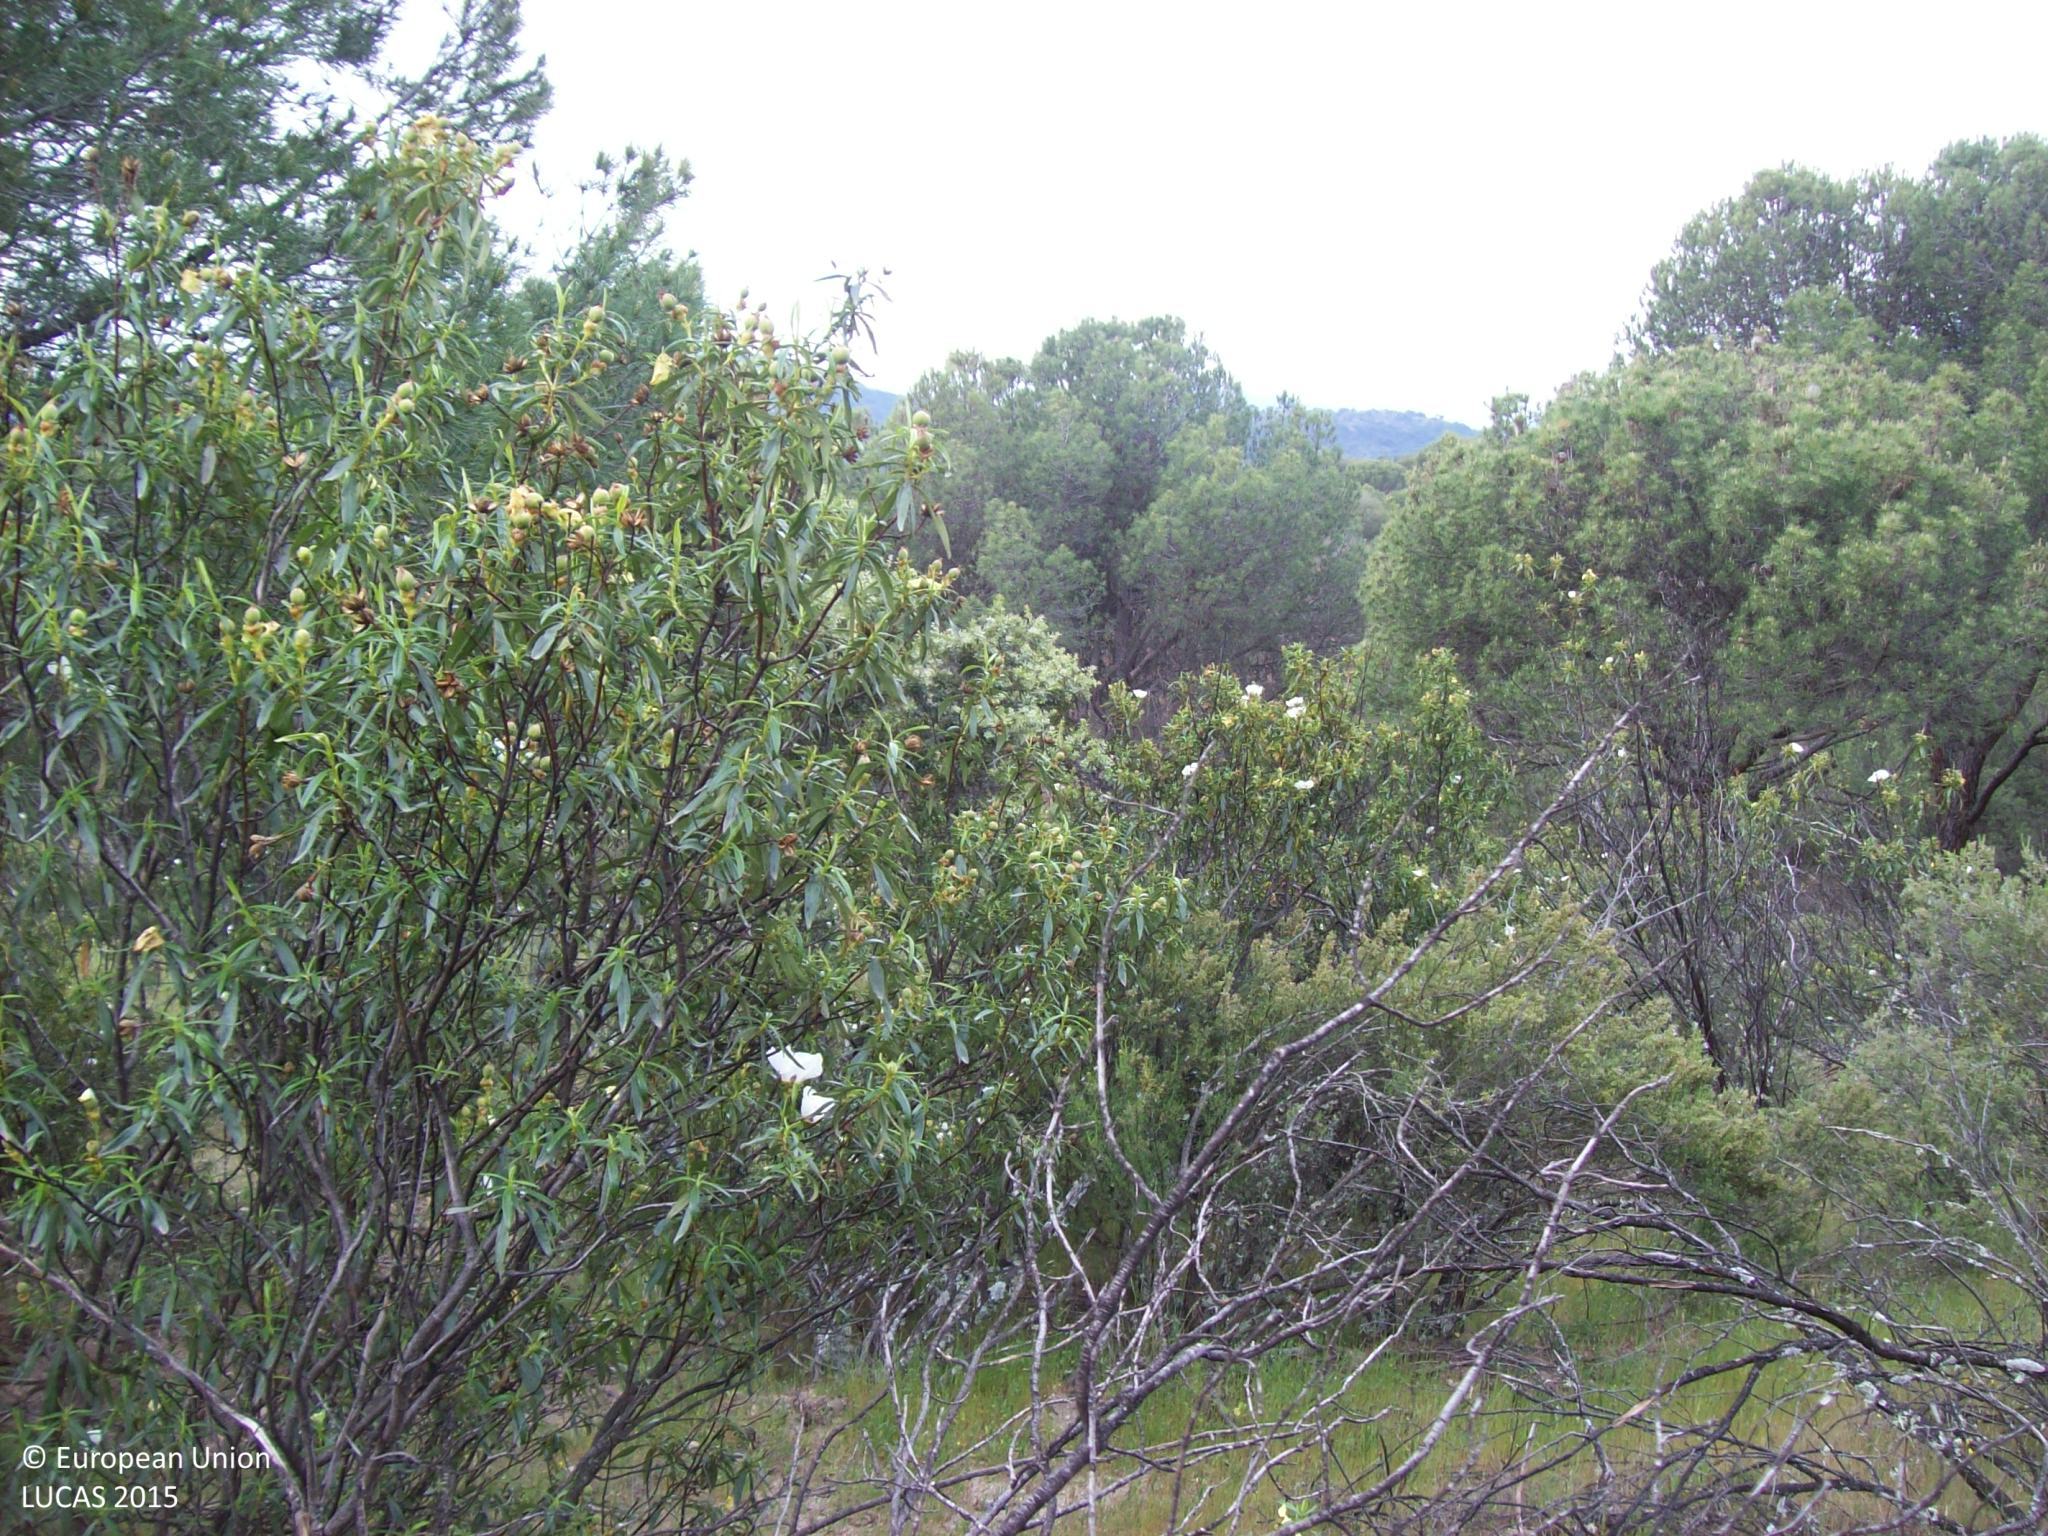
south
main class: Woodland
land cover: Pine dominated coniferous woodland
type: coniferous forest of the mediterranean region
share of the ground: 25 - 50 %
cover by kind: shrubs 40 %, herbaceous plants 35 %, coniferous forest trees 25 %
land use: Sport
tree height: > 5 m
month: April
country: ES
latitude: 40.4288
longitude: -4.3927
